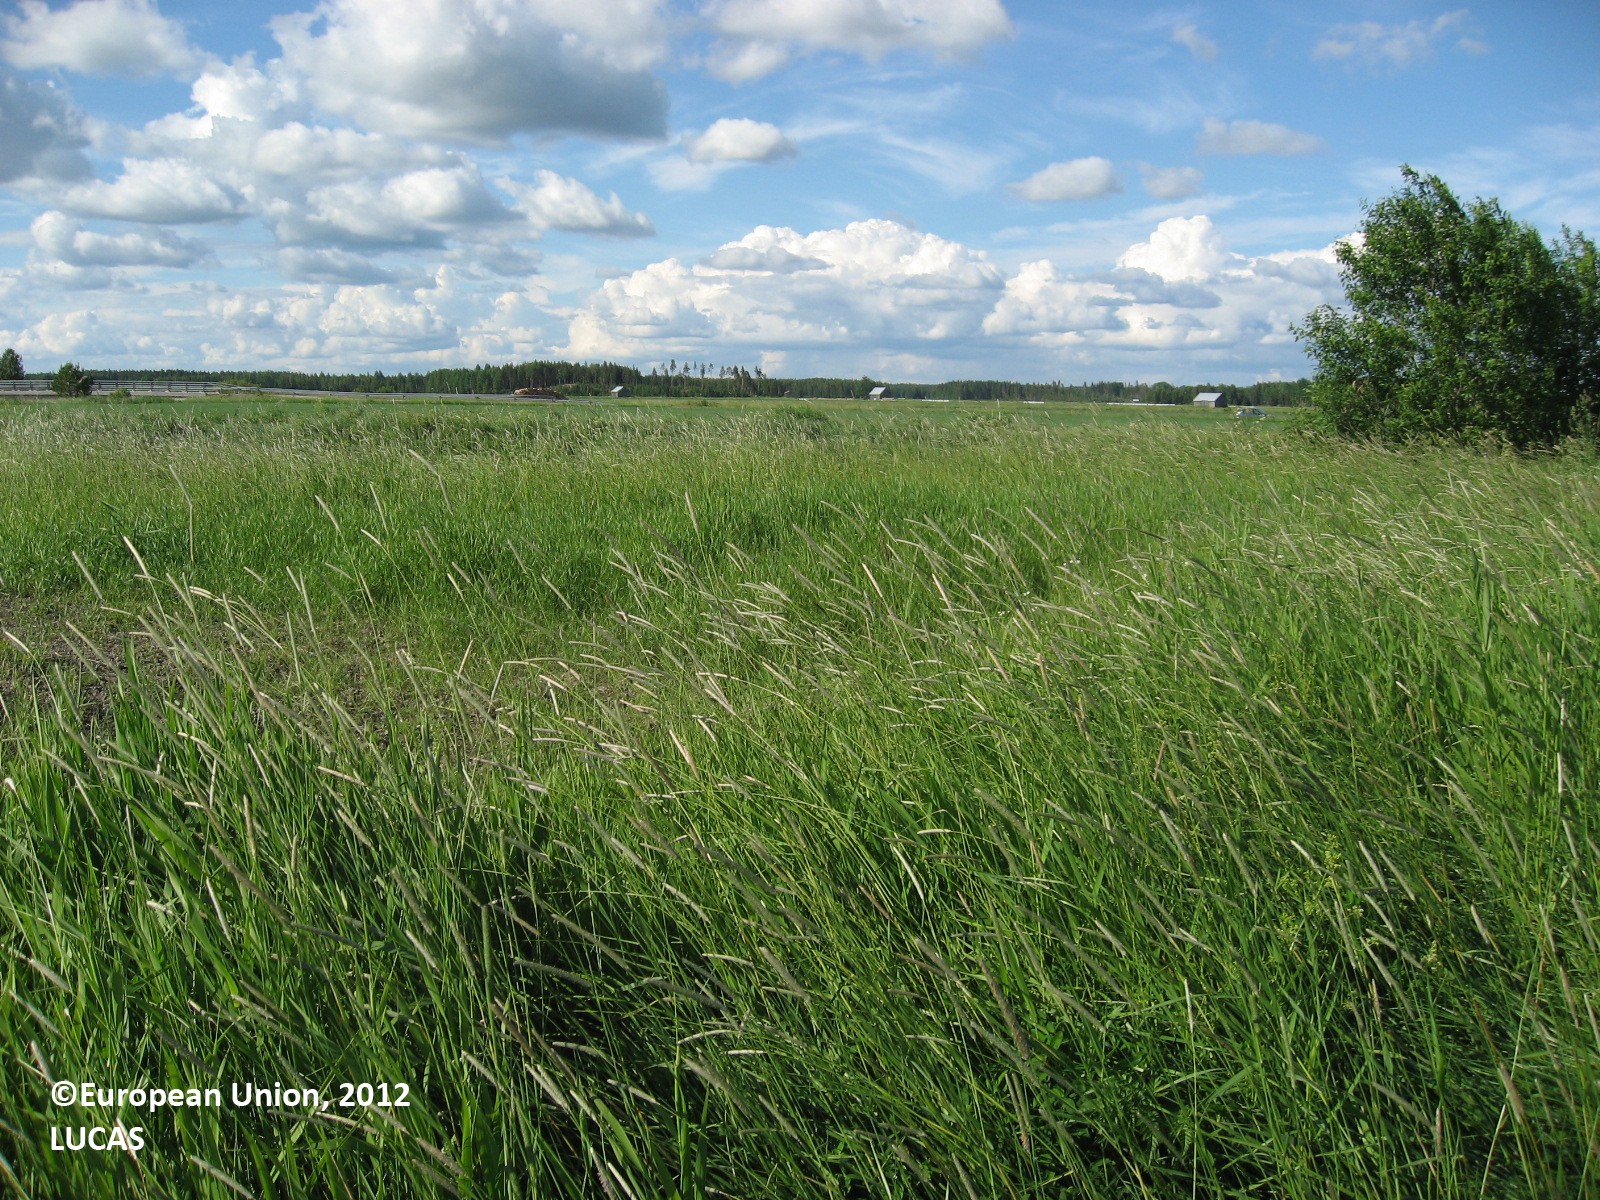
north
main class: Cropland
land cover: Common wheat
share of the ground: 50 - 75 %
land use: Agriculture (excluding fallow land and kitchen gardens)
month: June
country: FI
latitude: 60.5871
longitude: 26.3051
